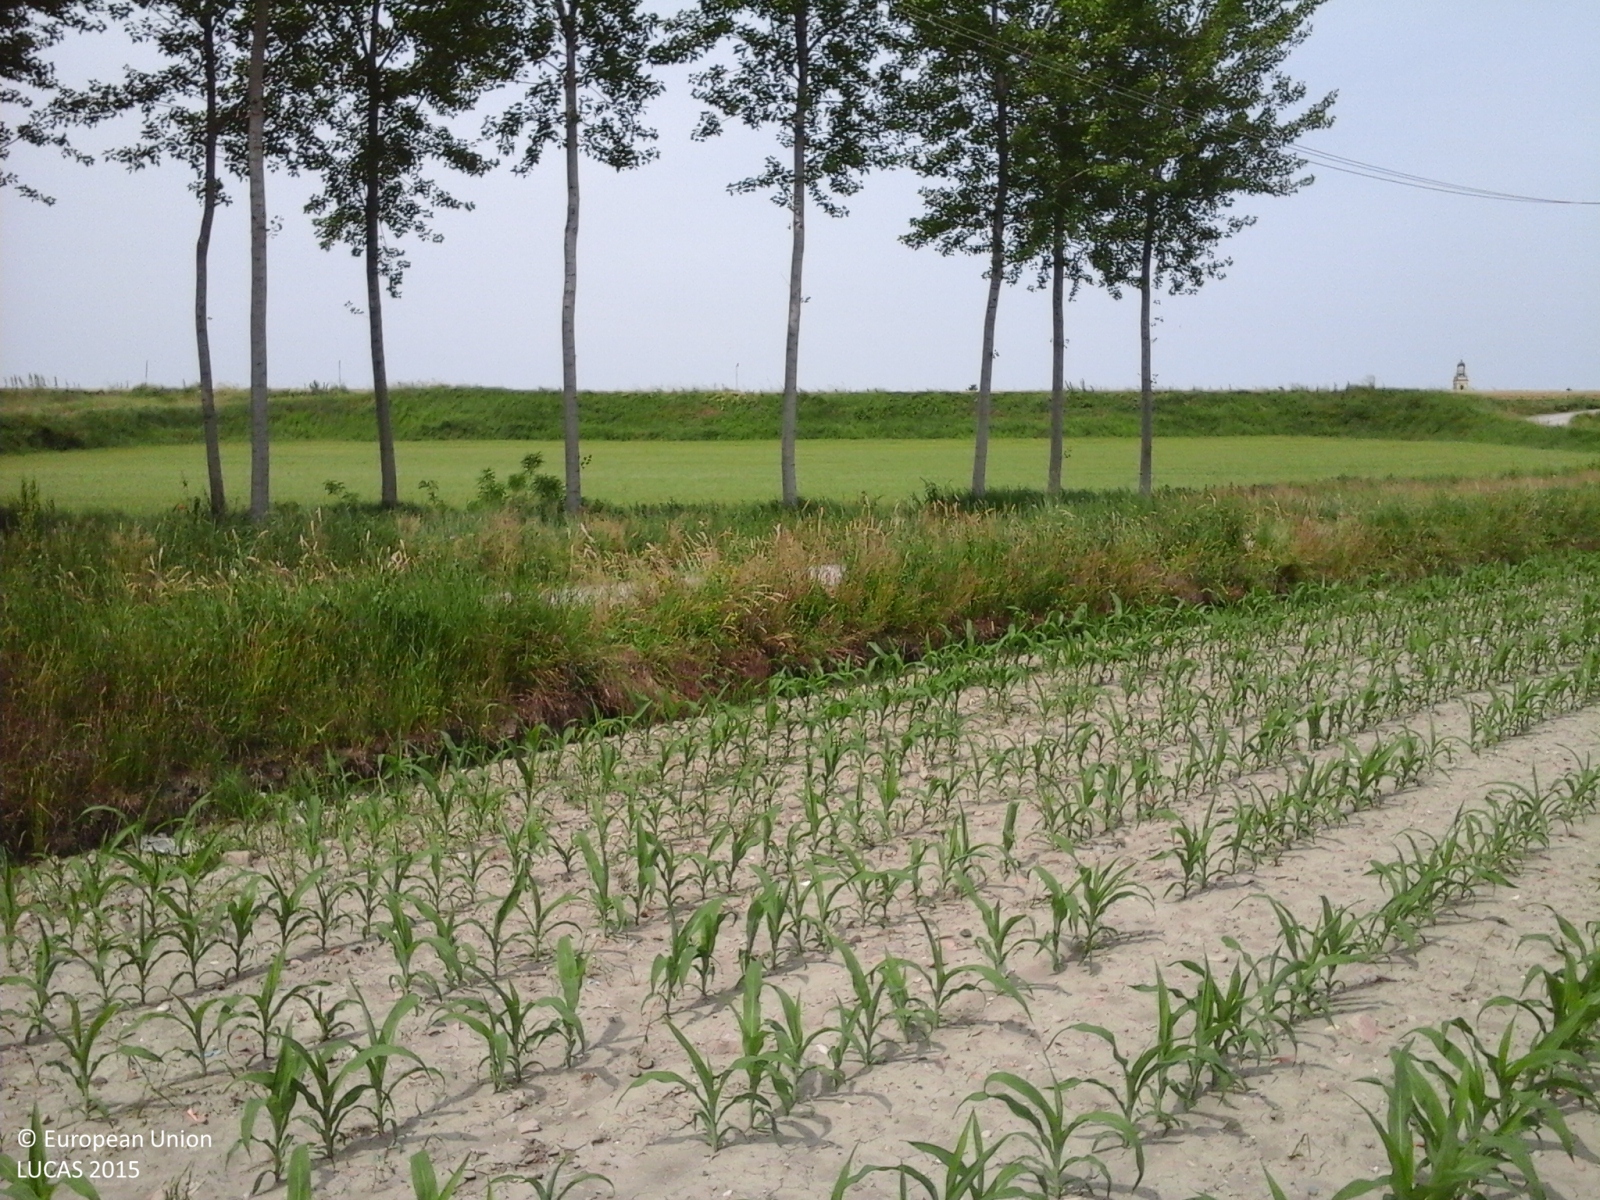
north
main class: Cropland
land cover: Maize
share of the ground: < 10 %
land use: Agriculture (excluding fallow land and kitchen gardens)
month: May
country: IT
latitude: 44.9990
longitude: 10.3925
